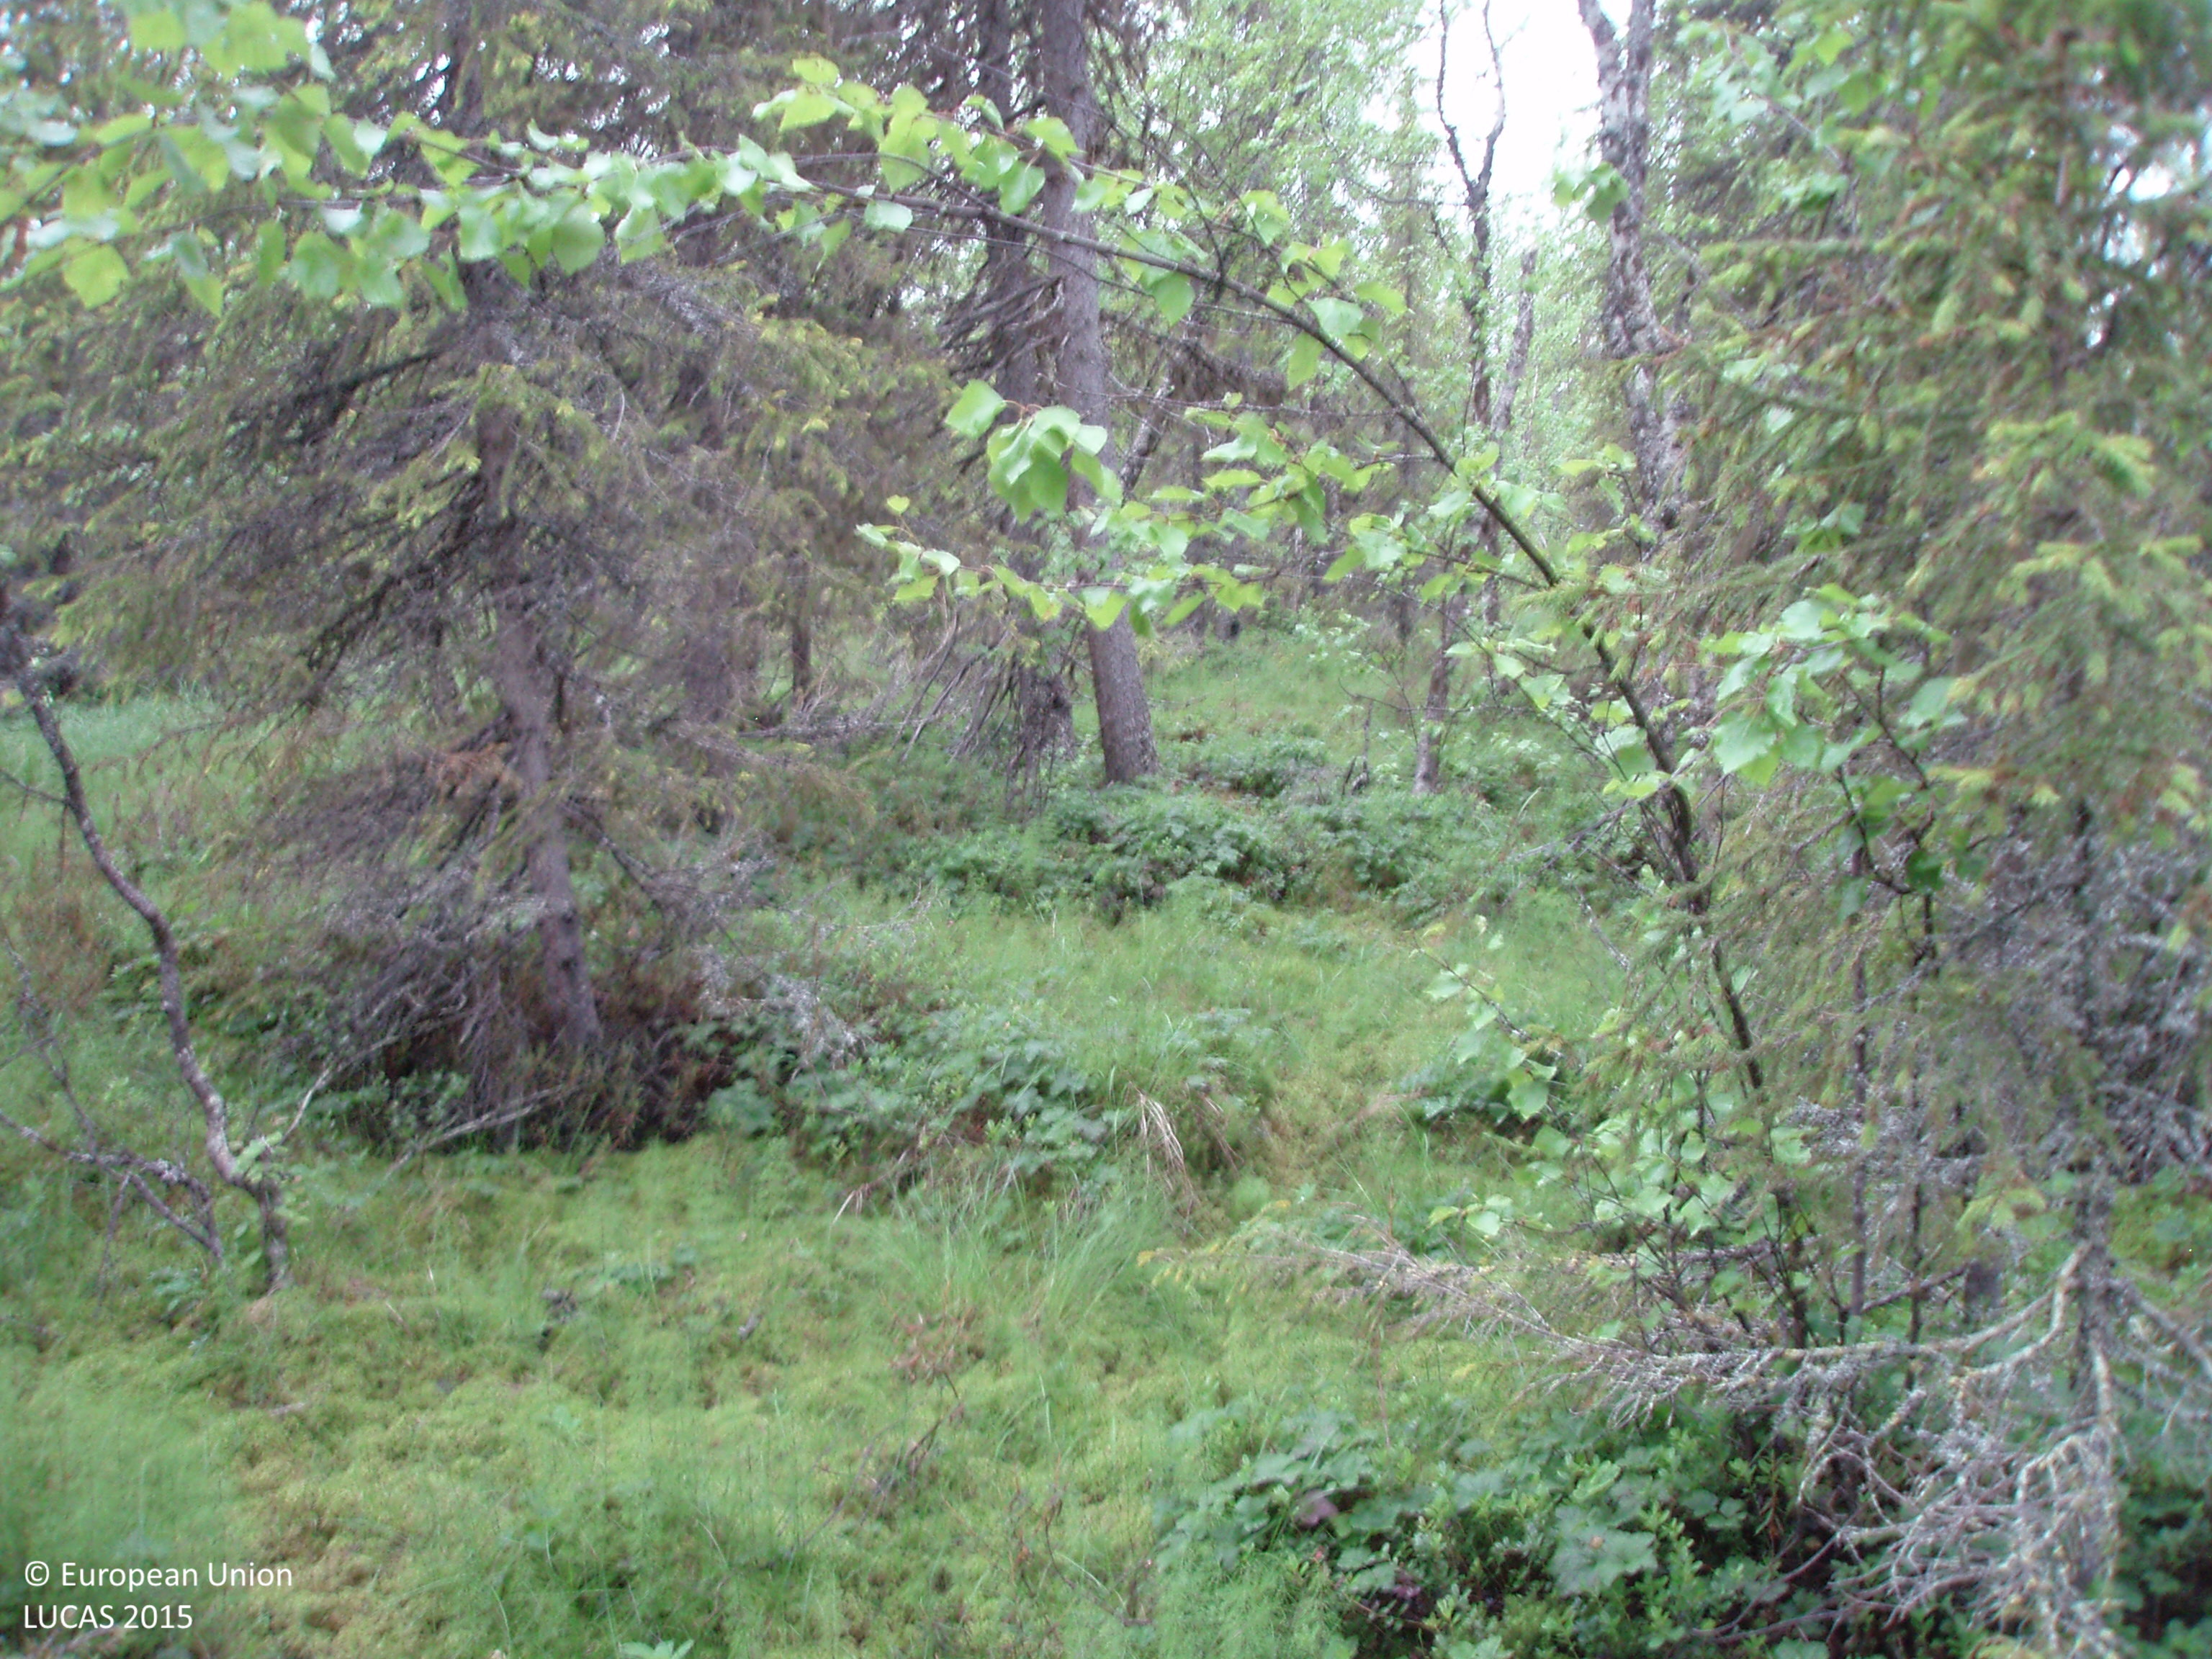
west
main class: Woodland
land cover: Spruce dominated mixed woodland
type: boreal forest
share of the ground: 50 - 75 %
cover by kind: coniferous forest trees 40 %, broadleaved forest trees 20 %, shrubs 20 %, herbaceous plants 20 %
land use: Forestry
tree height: > 5 m
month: July
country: FI
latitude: 67.2714
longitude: 28.2381
